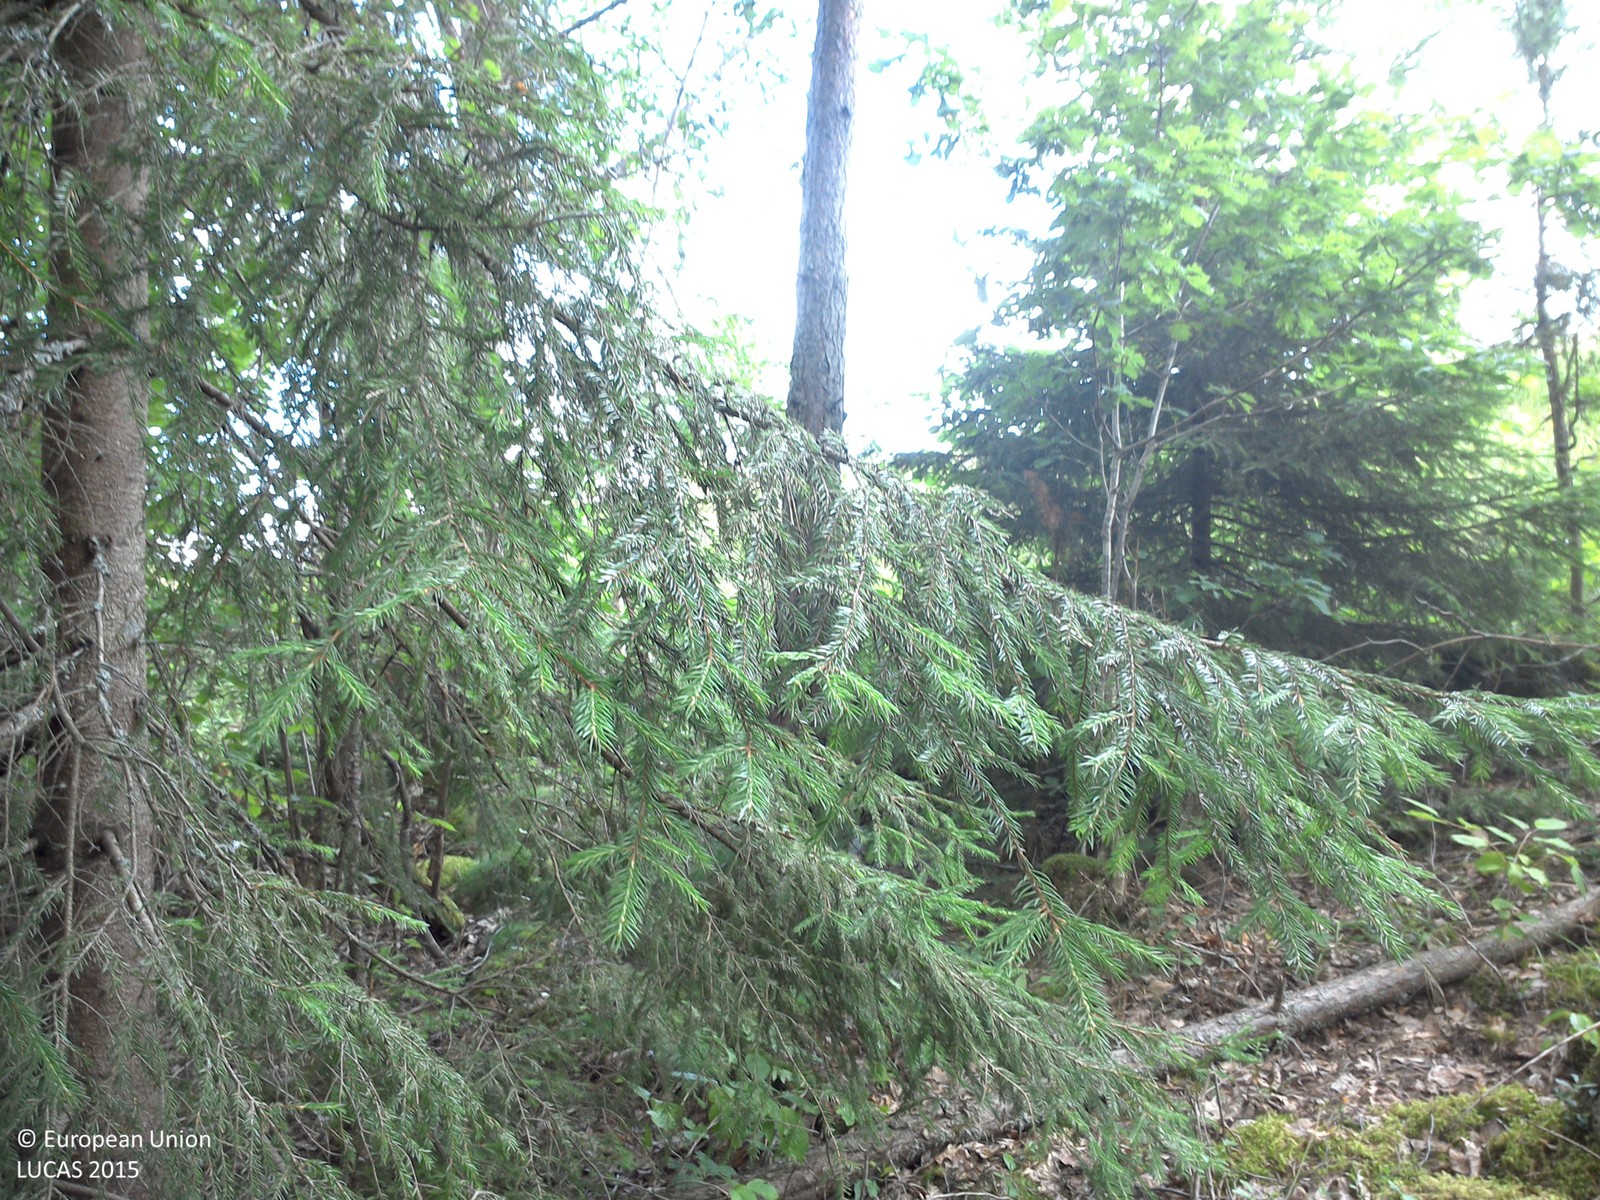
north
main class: Woodland
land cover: Spruce dominated mixed woodland
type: boreal forest
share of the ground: > 75 %
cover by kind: coniferous forest trees 50 %, broadleaved forest trees 25 %, herbaceous plants 15 %, lichens and mosses 10 %
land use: Forestry
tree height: > 5 m
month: July
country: SE
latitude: 57.9042
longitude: 16.0209
